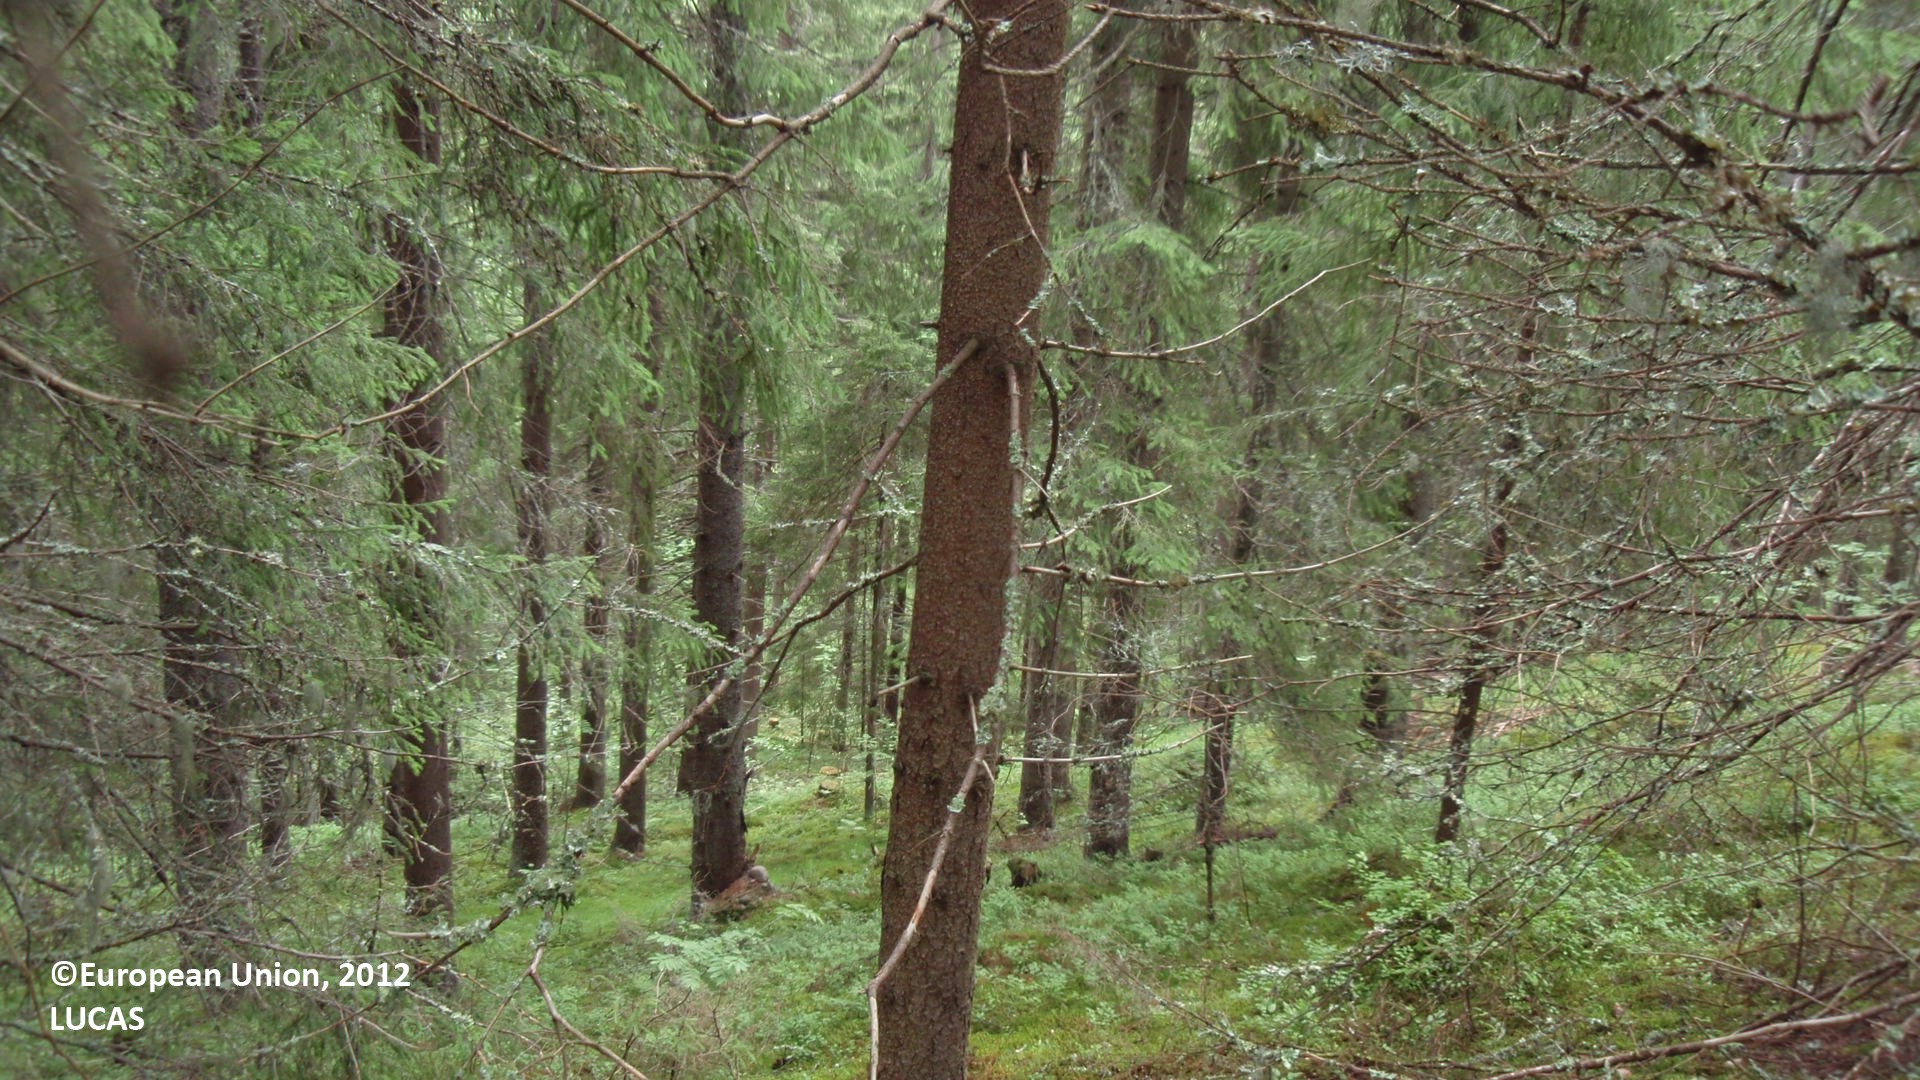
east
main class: Woodland
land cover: Spruce dominated coniferous woodland
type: boreal forest
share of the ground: 50 - 75 %
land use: Forestry
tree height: > 5 m
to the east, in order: Spruce dominated coniferous woodland; Grassland with sparse tree/shrub cover; Ditches and canals; Grassland with sparse tree/shrub cover; Broadleaved woodland; Shrubland with sparse tree cover
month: July
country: FI
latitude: 61.1222
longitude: 28.5764
